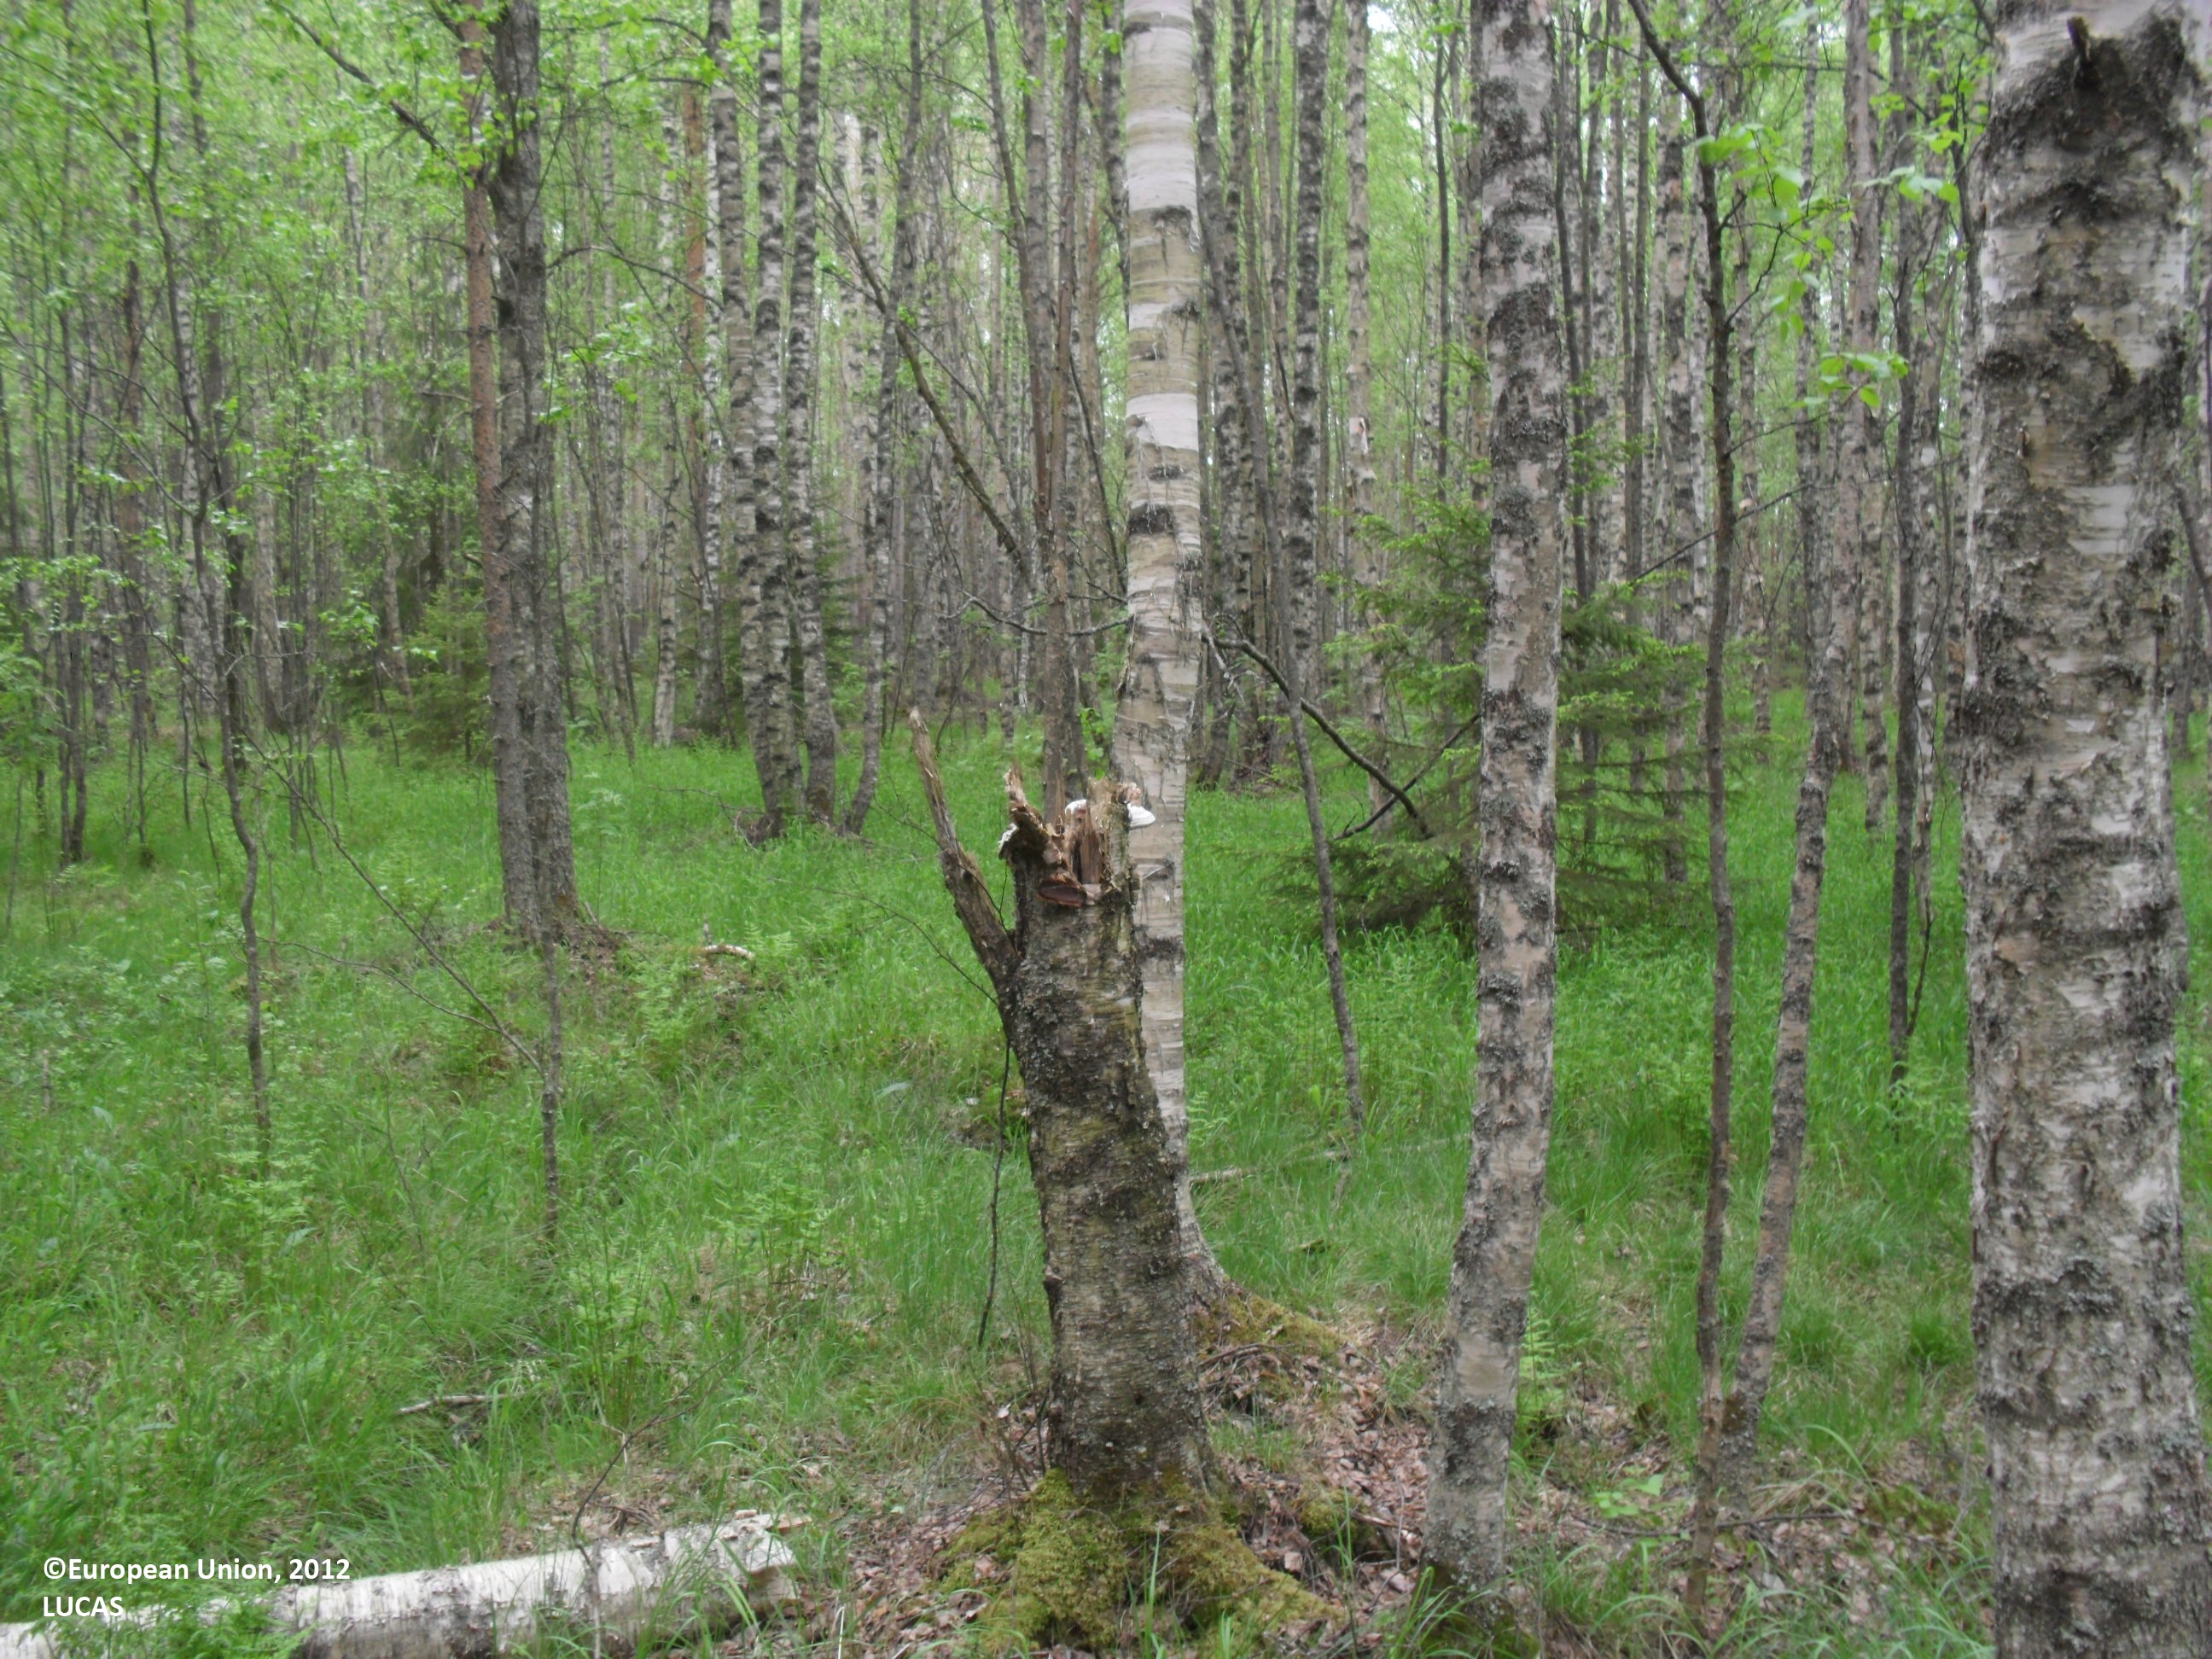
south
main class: Woodland
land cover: Other mixed woodland
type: boreal forest
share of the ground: 50 - 75 %
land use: Forestry
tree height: > 5 m
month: June
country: FI
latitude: 62.9112
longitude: 22.9517
